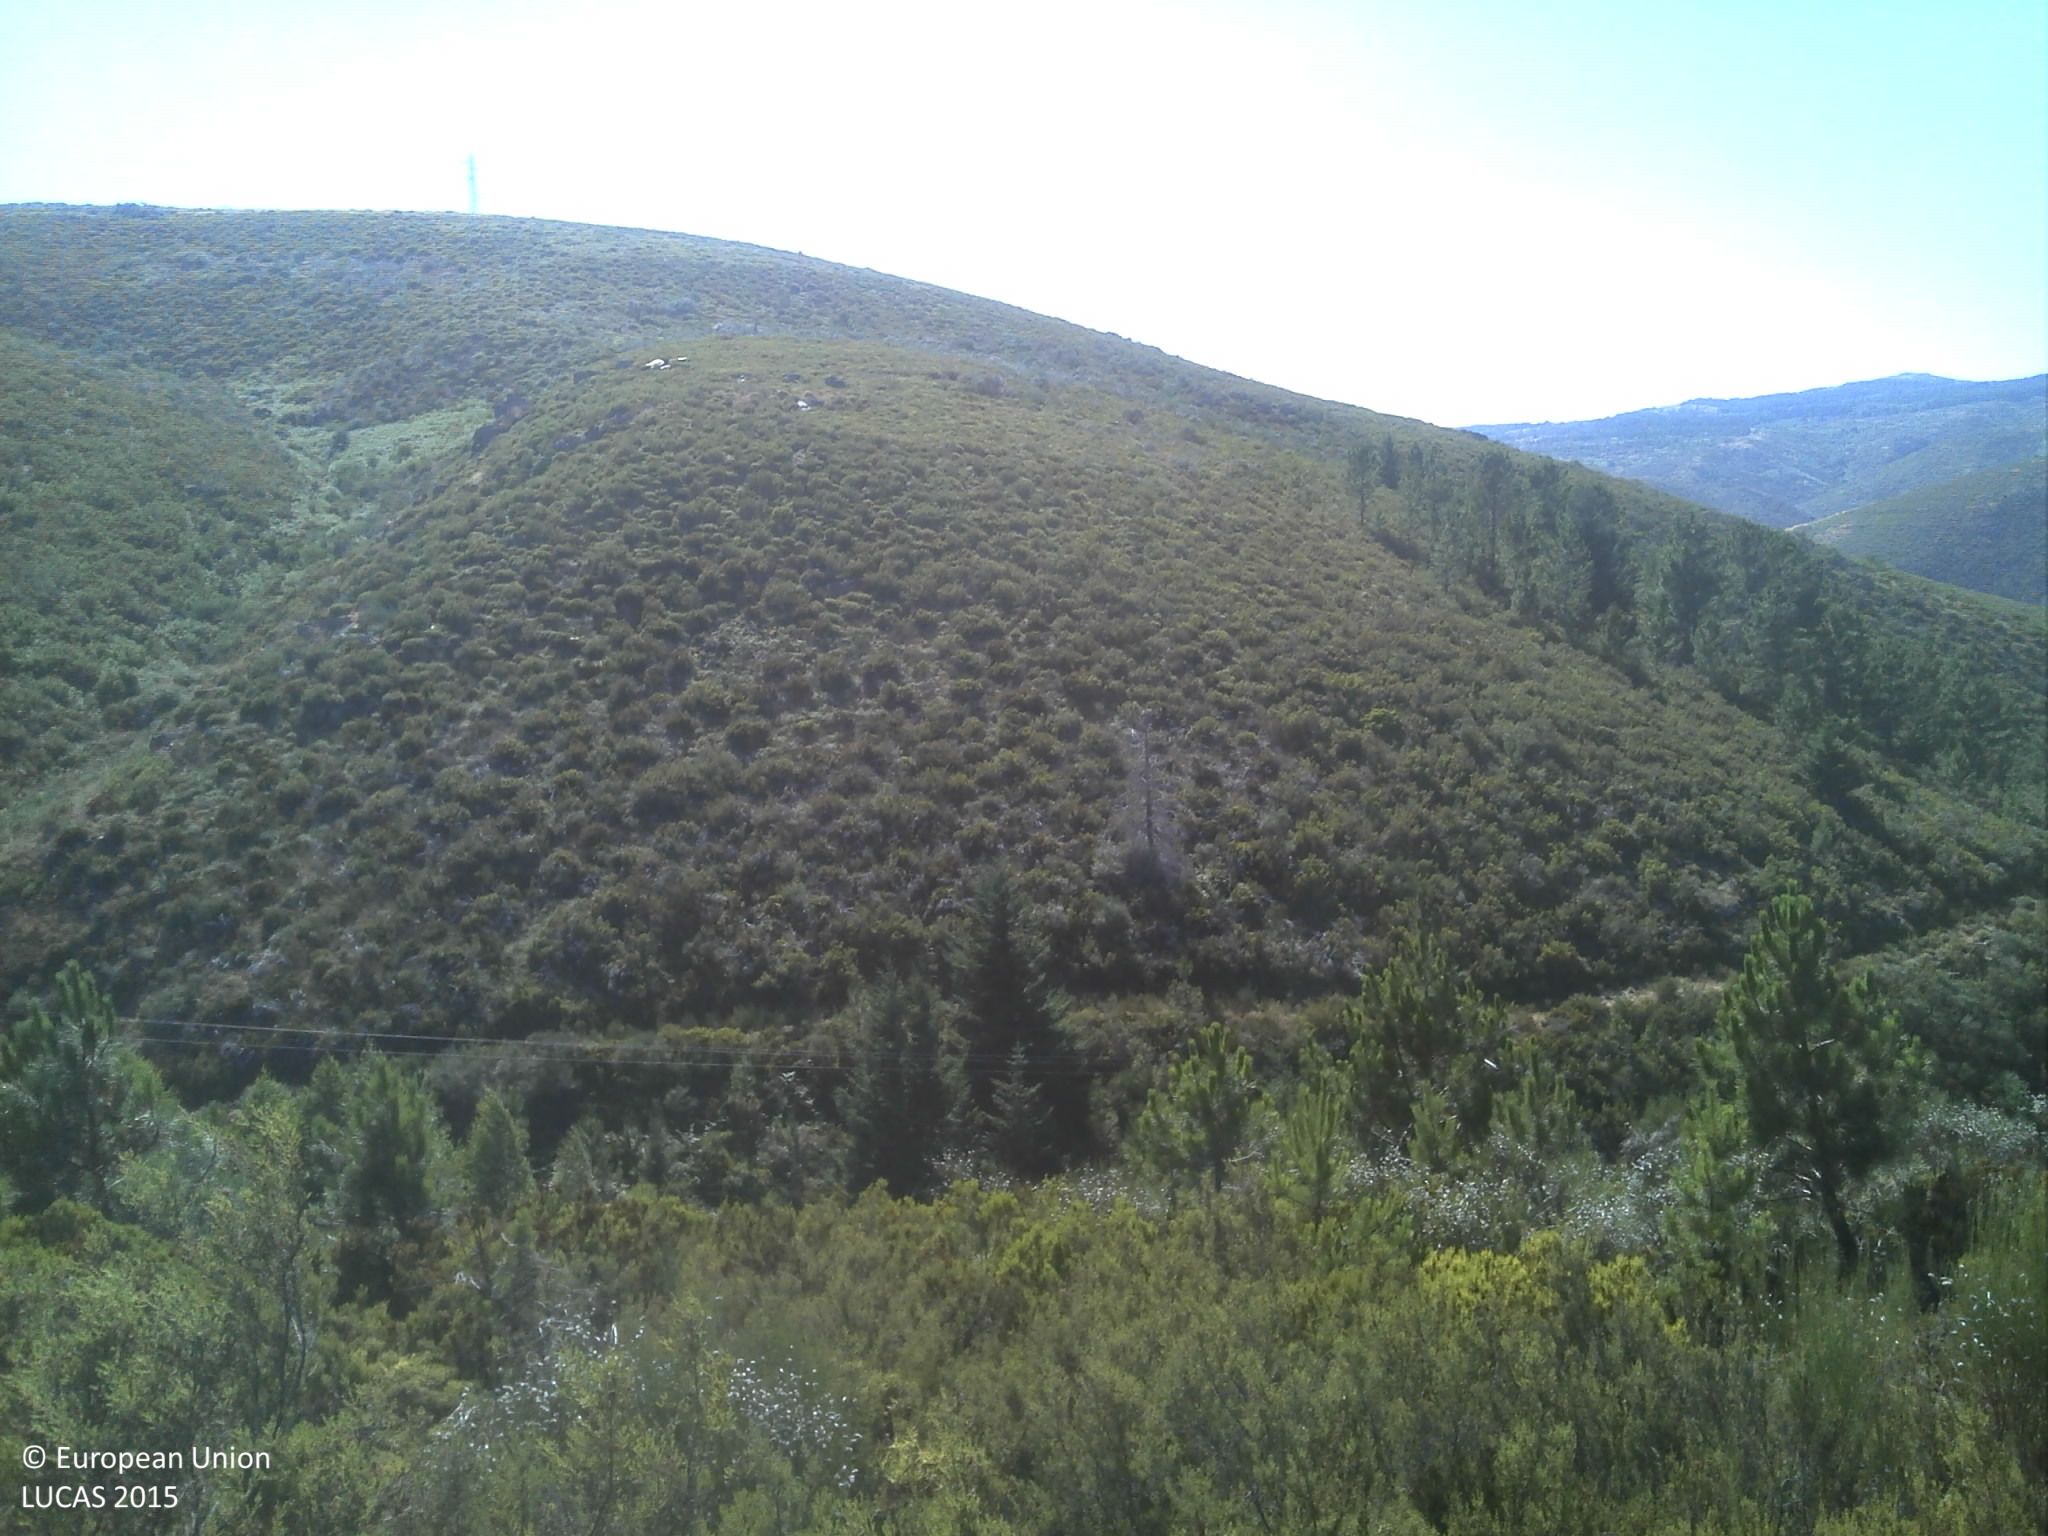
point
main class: Shrubland
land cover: Shrubland with sparse tree cover
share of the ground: 50 - 75 %
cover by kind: shrubs 75 %, unconsolidated bare surface 15 %, coniferous forest trees 5 %
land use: Semi-natural and natural areas not in use
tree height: > 5 m
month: July
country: PT
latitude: 40.4261
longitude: -7.5436
